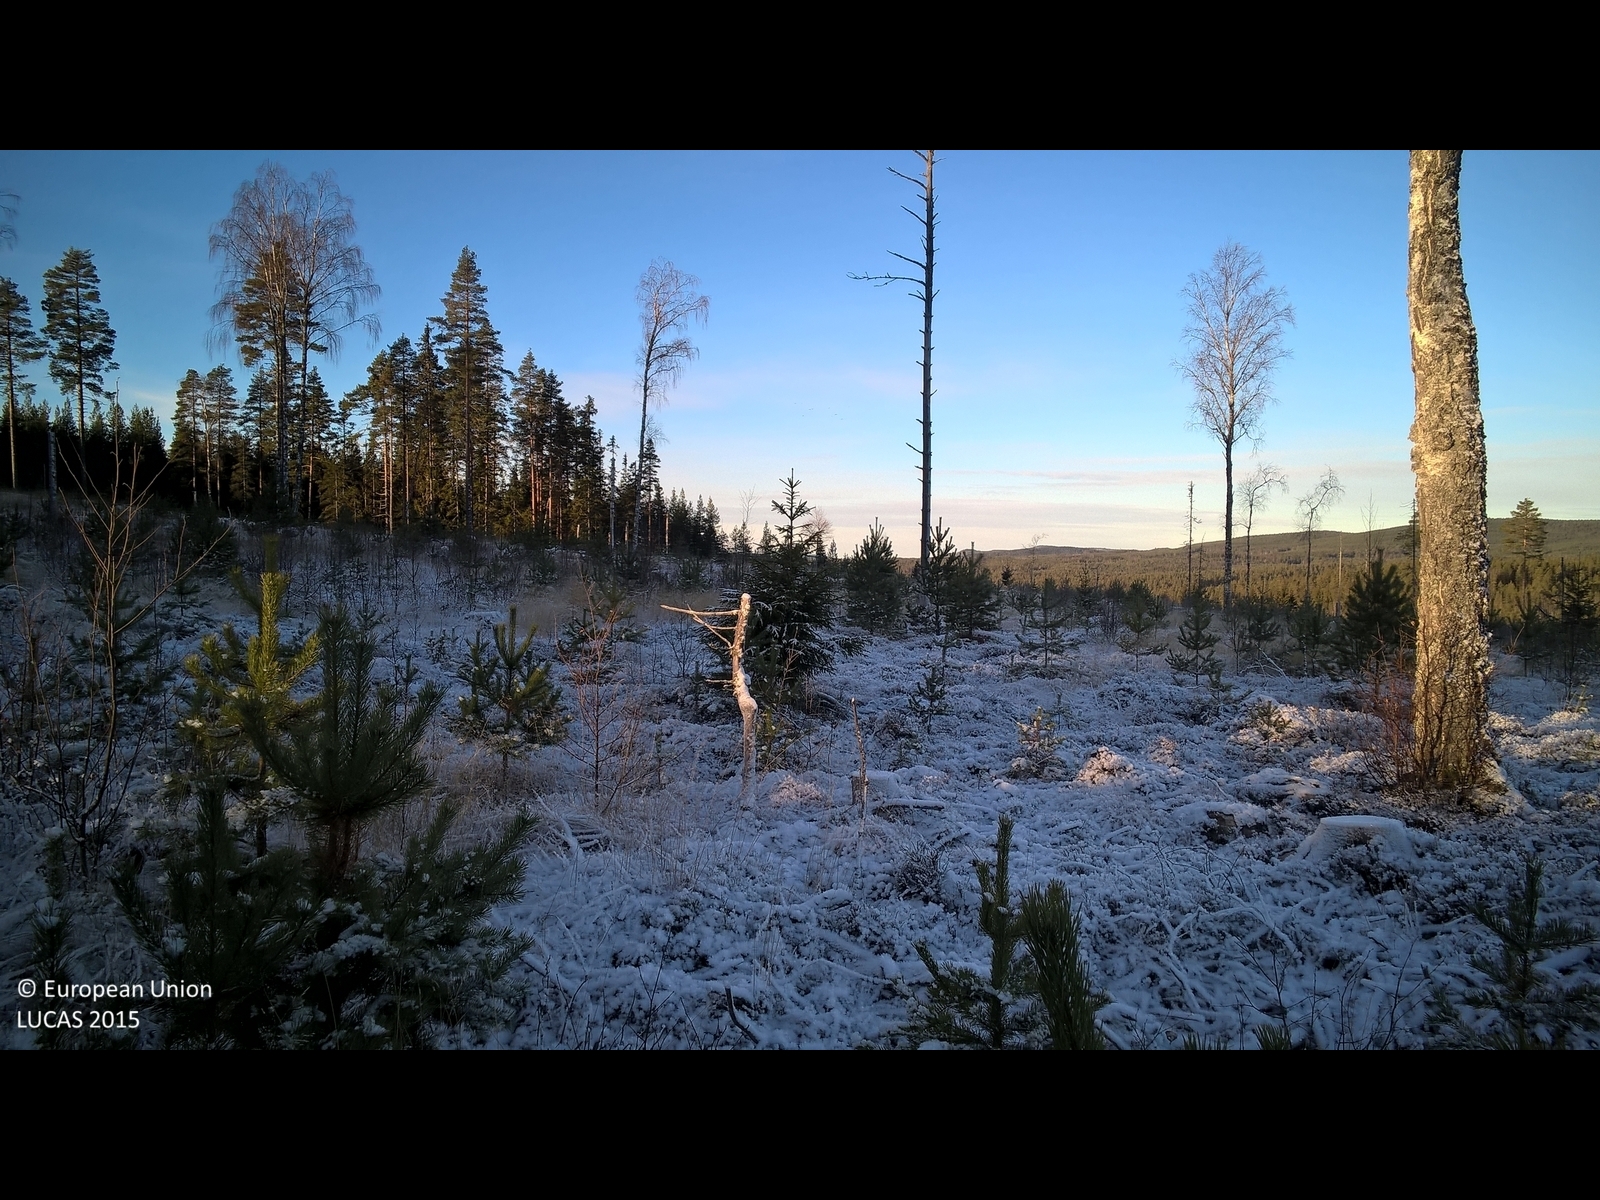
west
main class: Woodland
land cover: Pine dominated coniferous woodland
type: boreal forest
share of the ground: 25 - 50 %
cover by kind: lichens and mosses 60 %, coniferous forest trees 30 %, herbaceous plants 10 %
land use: Forestry
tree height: < 5 m
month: November
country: SE
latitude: 60.7014
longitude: 14.5856
